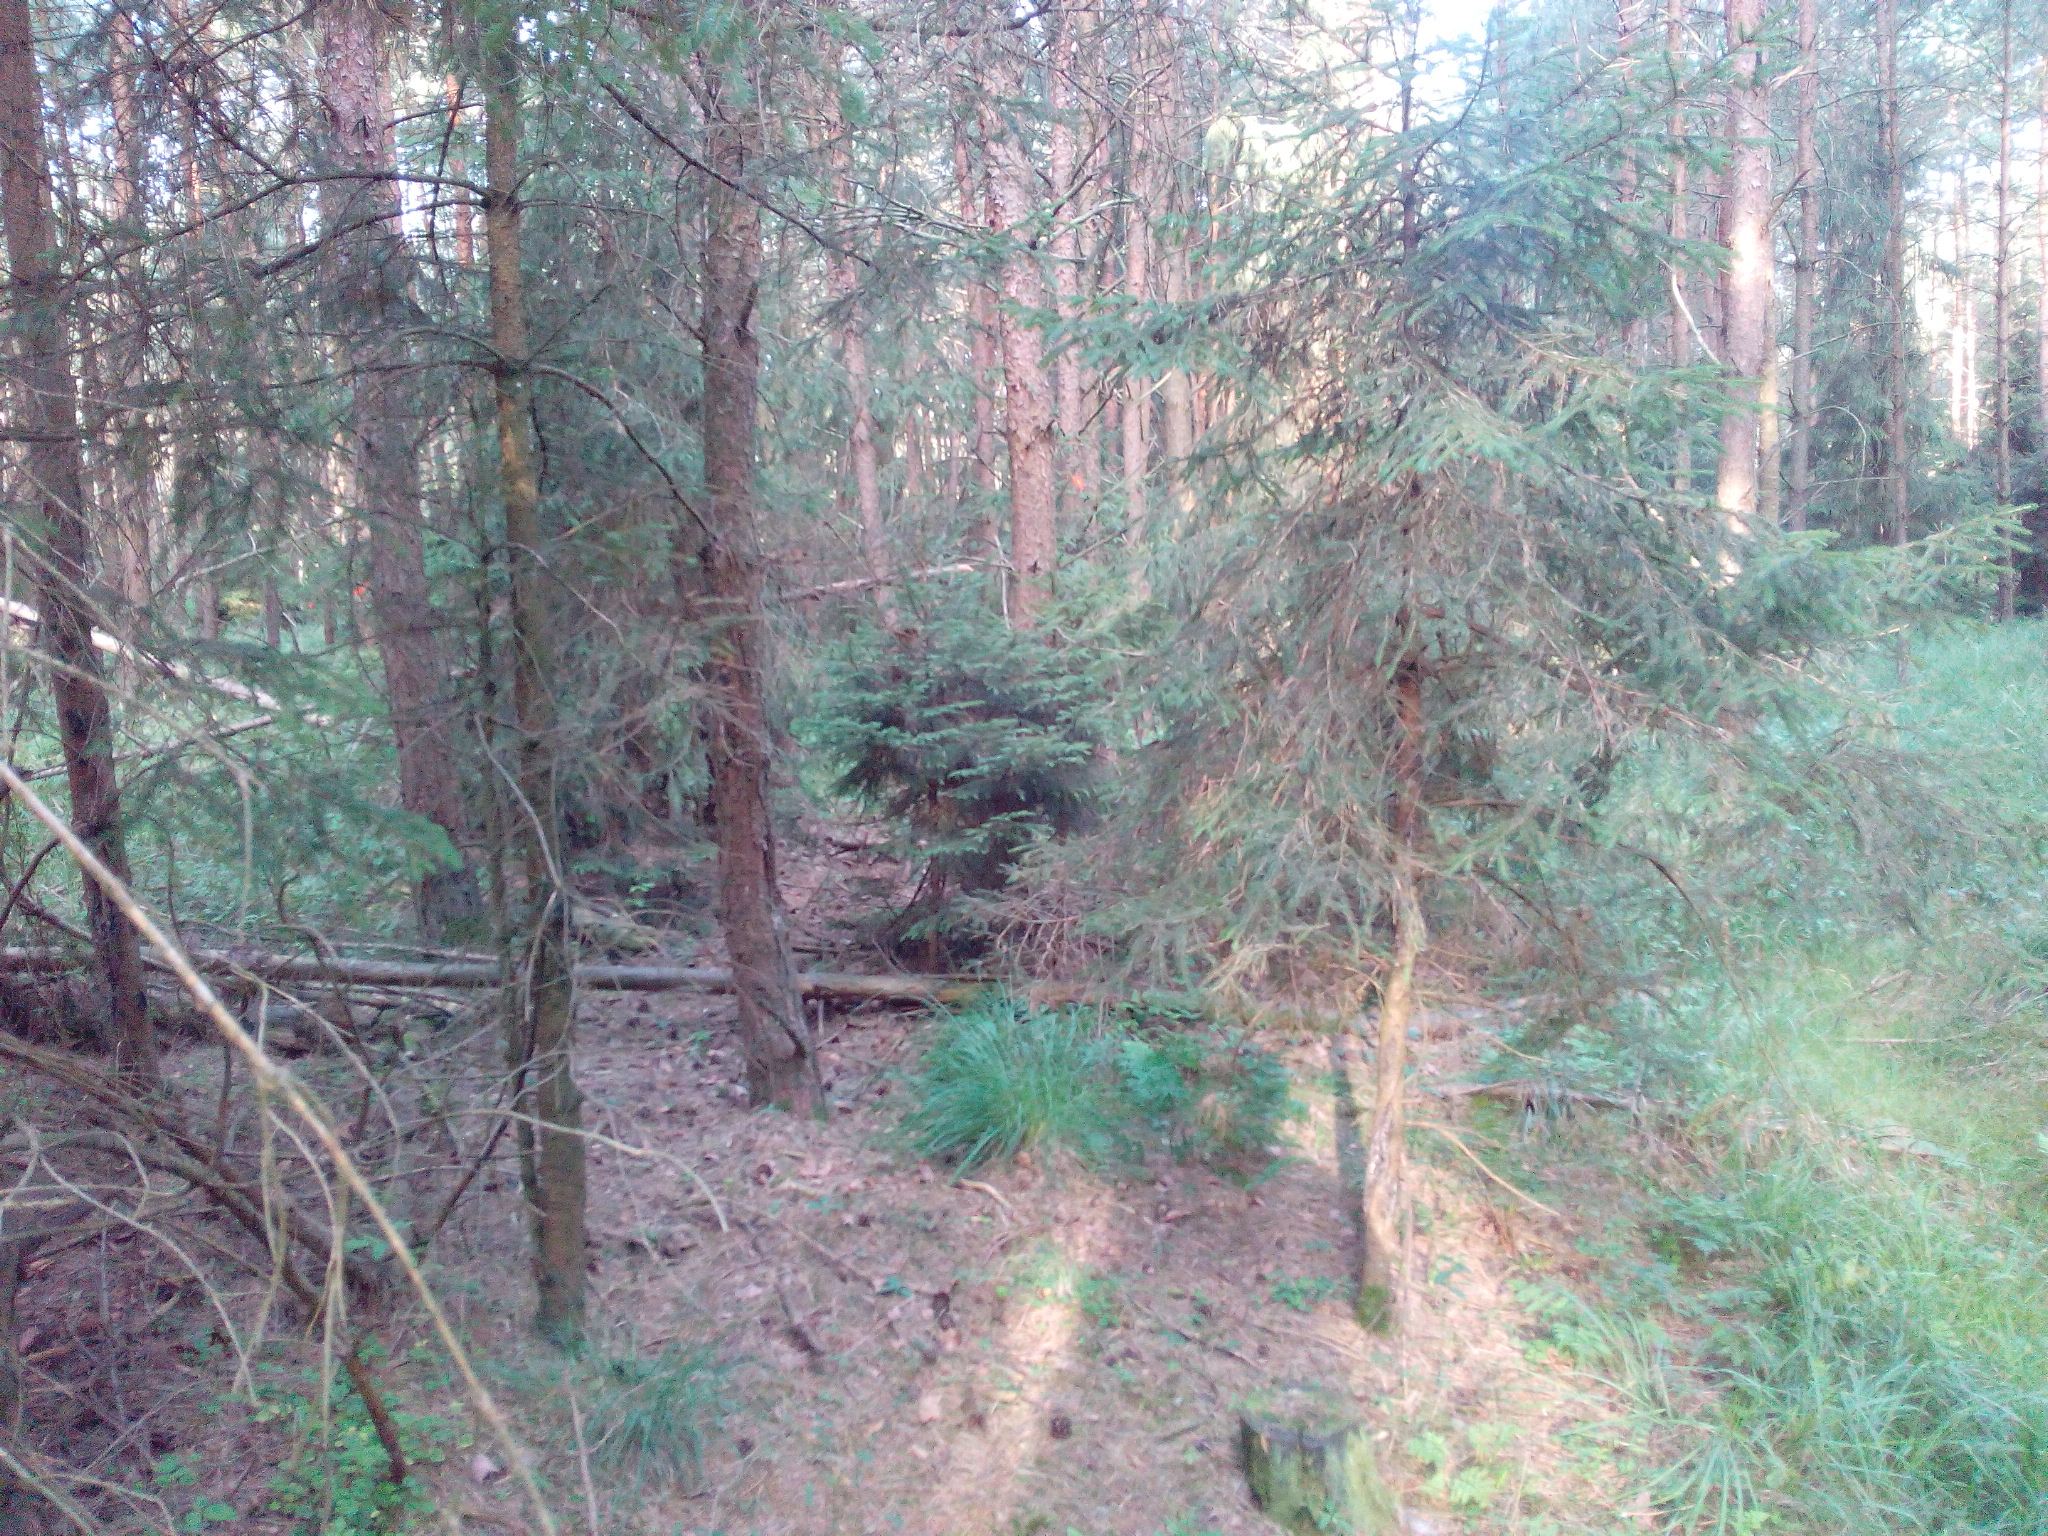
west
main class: Woodland
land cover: Spruce dominated coniferous woodland
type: hemiboreal forest and nemoral coniferous forest and mixed broadleaved-coniferous forest
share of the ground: > 75 %
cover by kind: coniferous forest trees 75 %, herbaceous plants 25 %
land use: Forestry
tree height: > 5 m
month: August
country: DE
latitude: 52.5931
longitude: 9.8967
